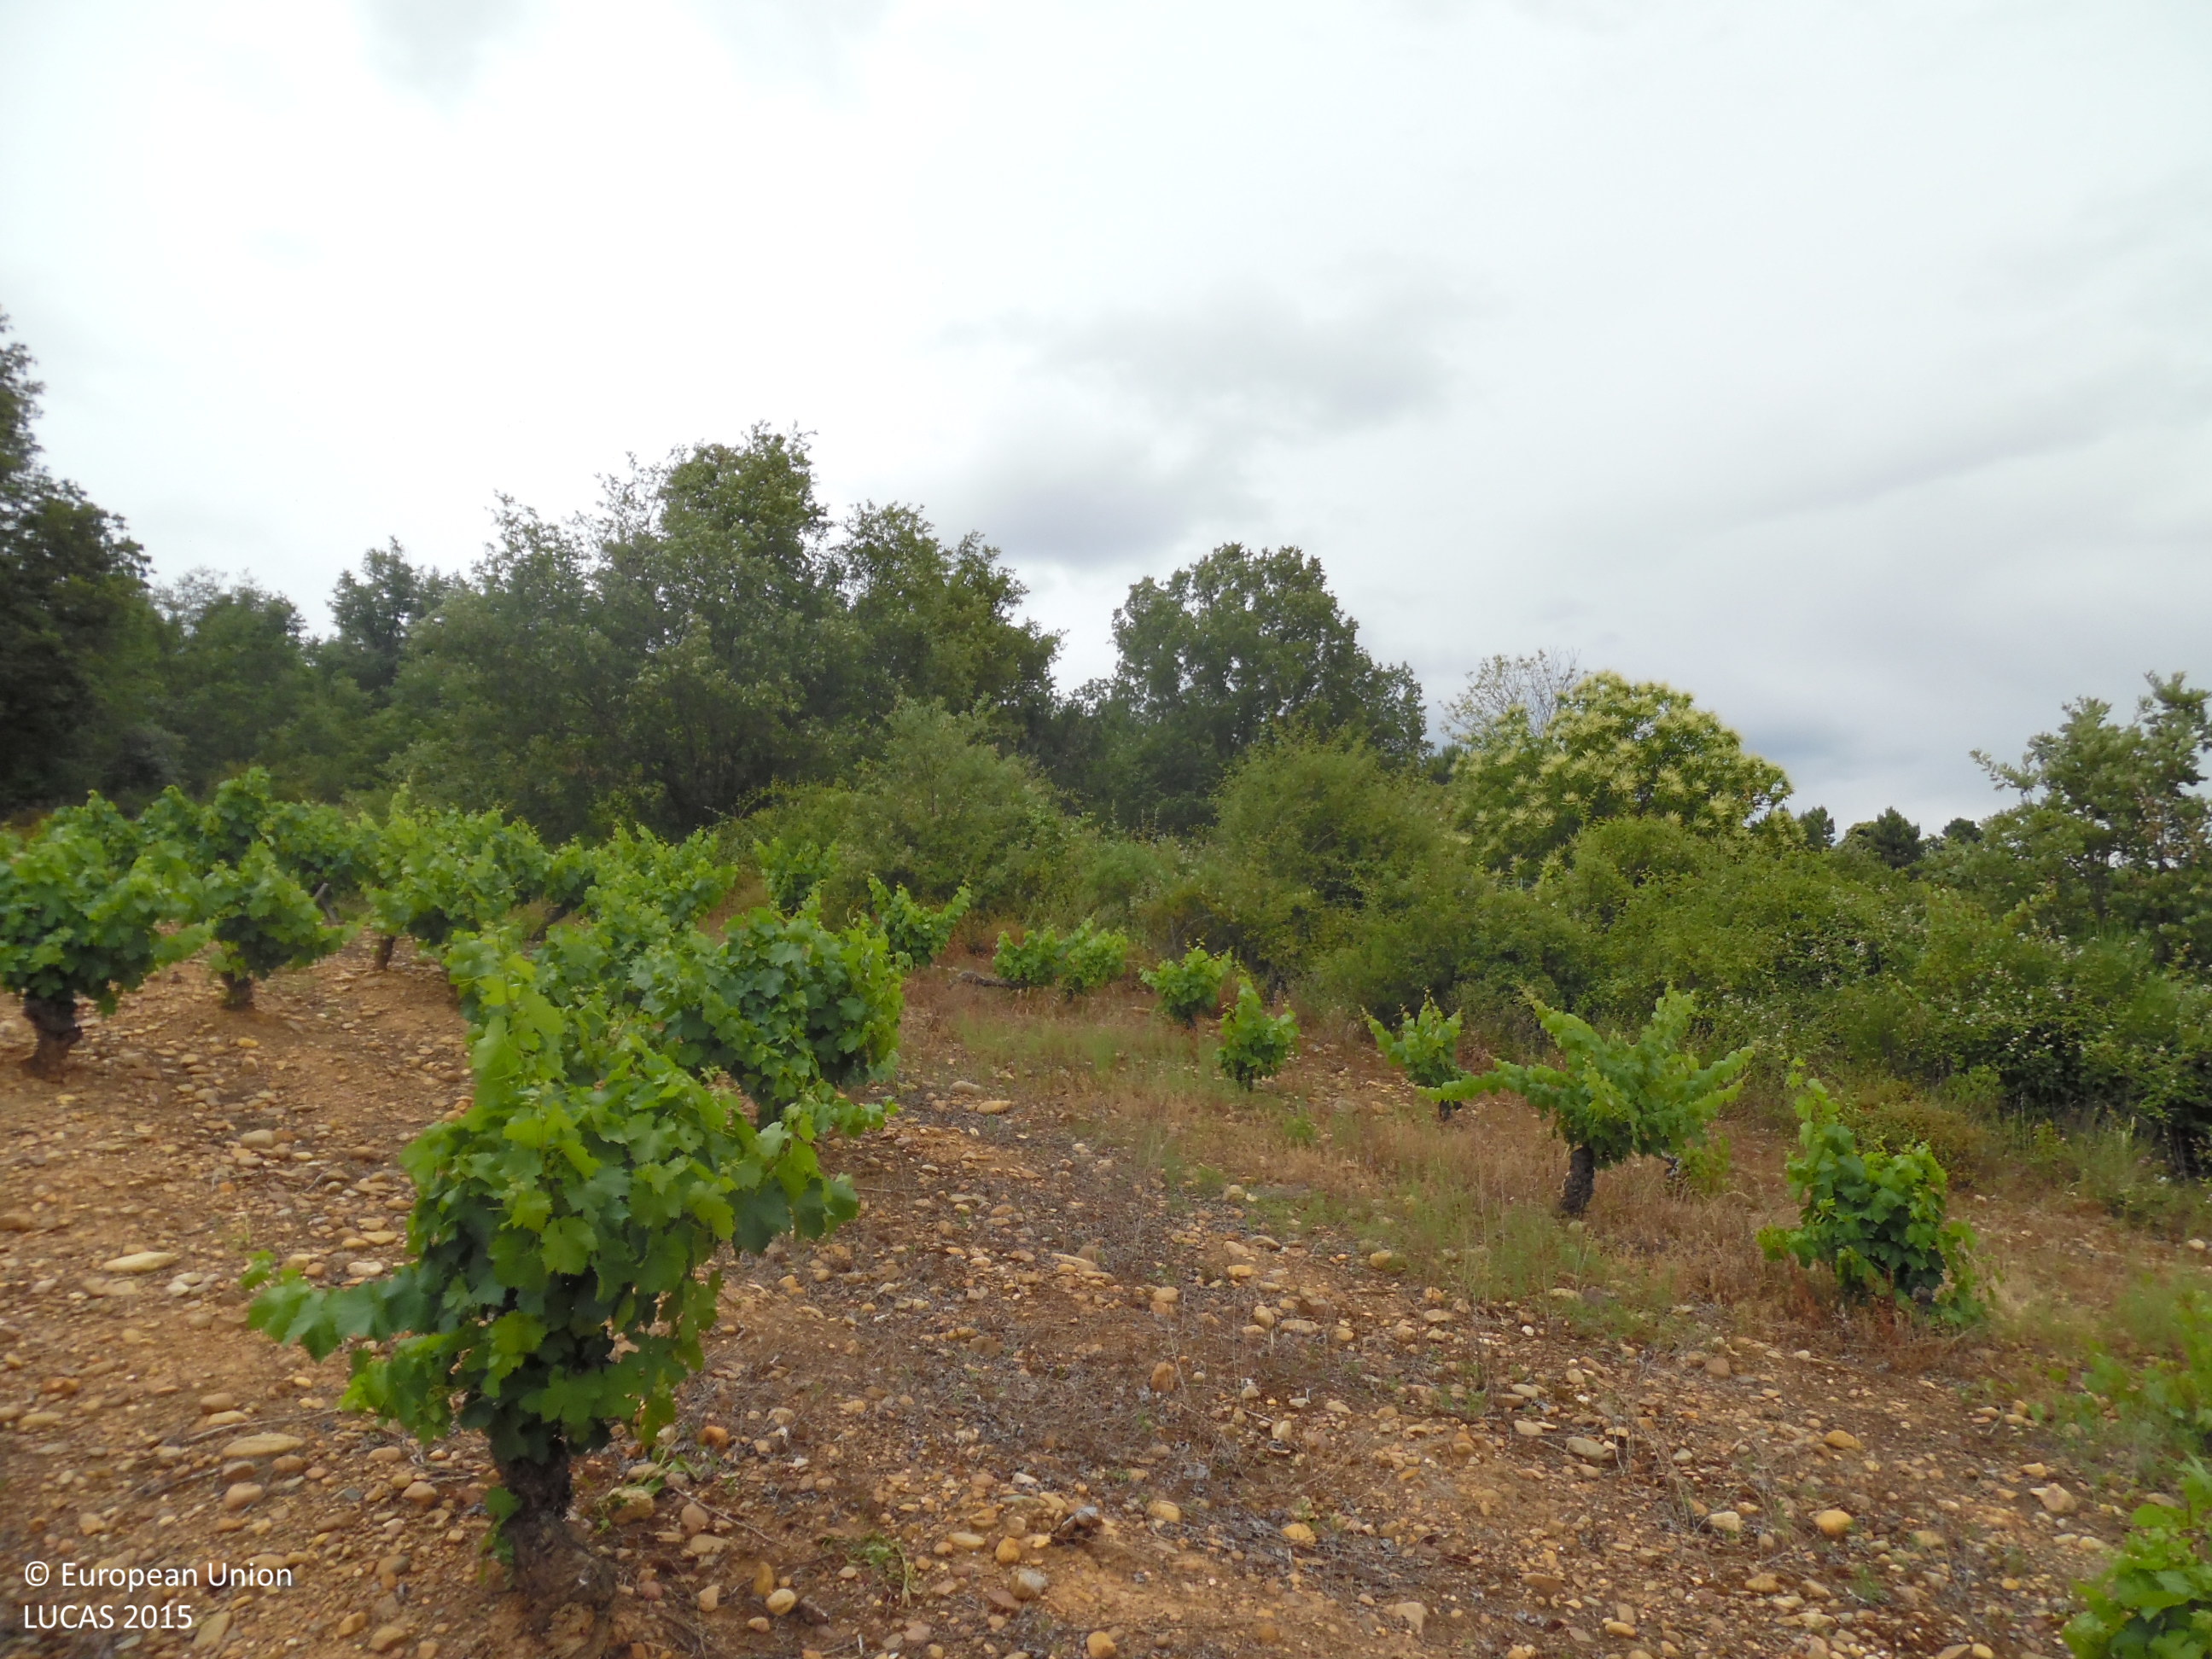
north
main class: Cropland
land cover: Vineyards
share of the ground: 50 - 75 %
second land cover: Other bare soil
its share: > 75 %
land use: Agriculture (excluding fallow land and kitchen gardens)
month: June
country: ES
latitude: 42.5720
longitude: -6.7529
